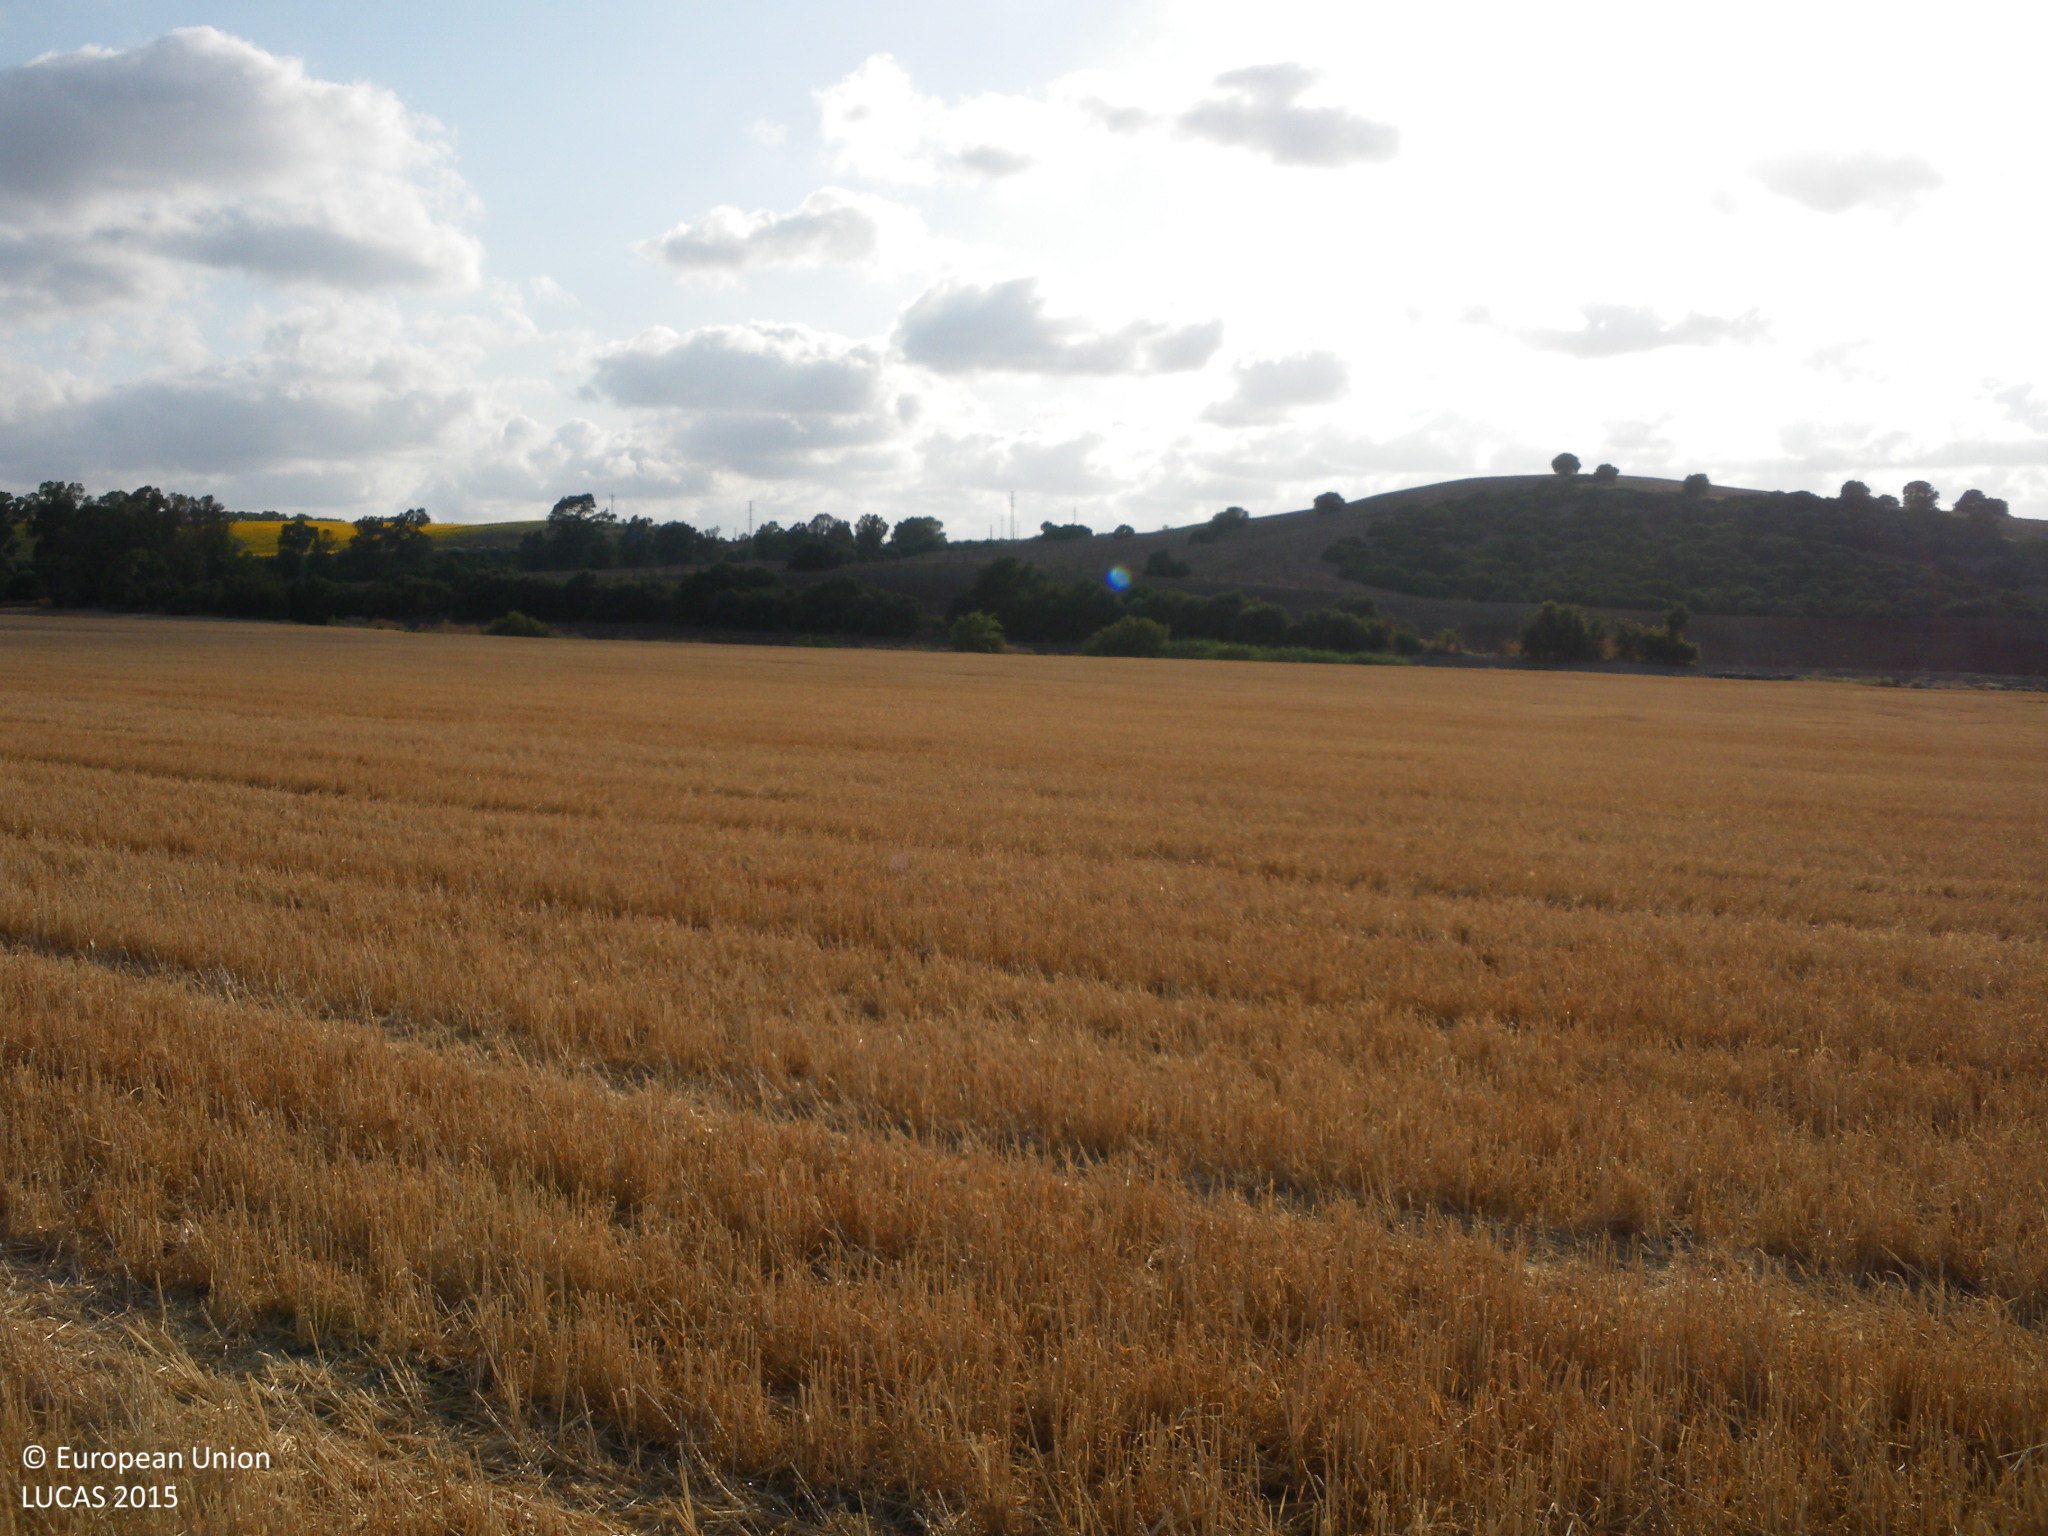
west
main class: Cropland
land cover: Durum wheat
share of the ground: < 10 %
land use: Agriculture (excluding fallow land and kitchen gardens)
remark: Harvested field
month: June
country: ES
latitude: 36.7175
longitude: -5.9868
